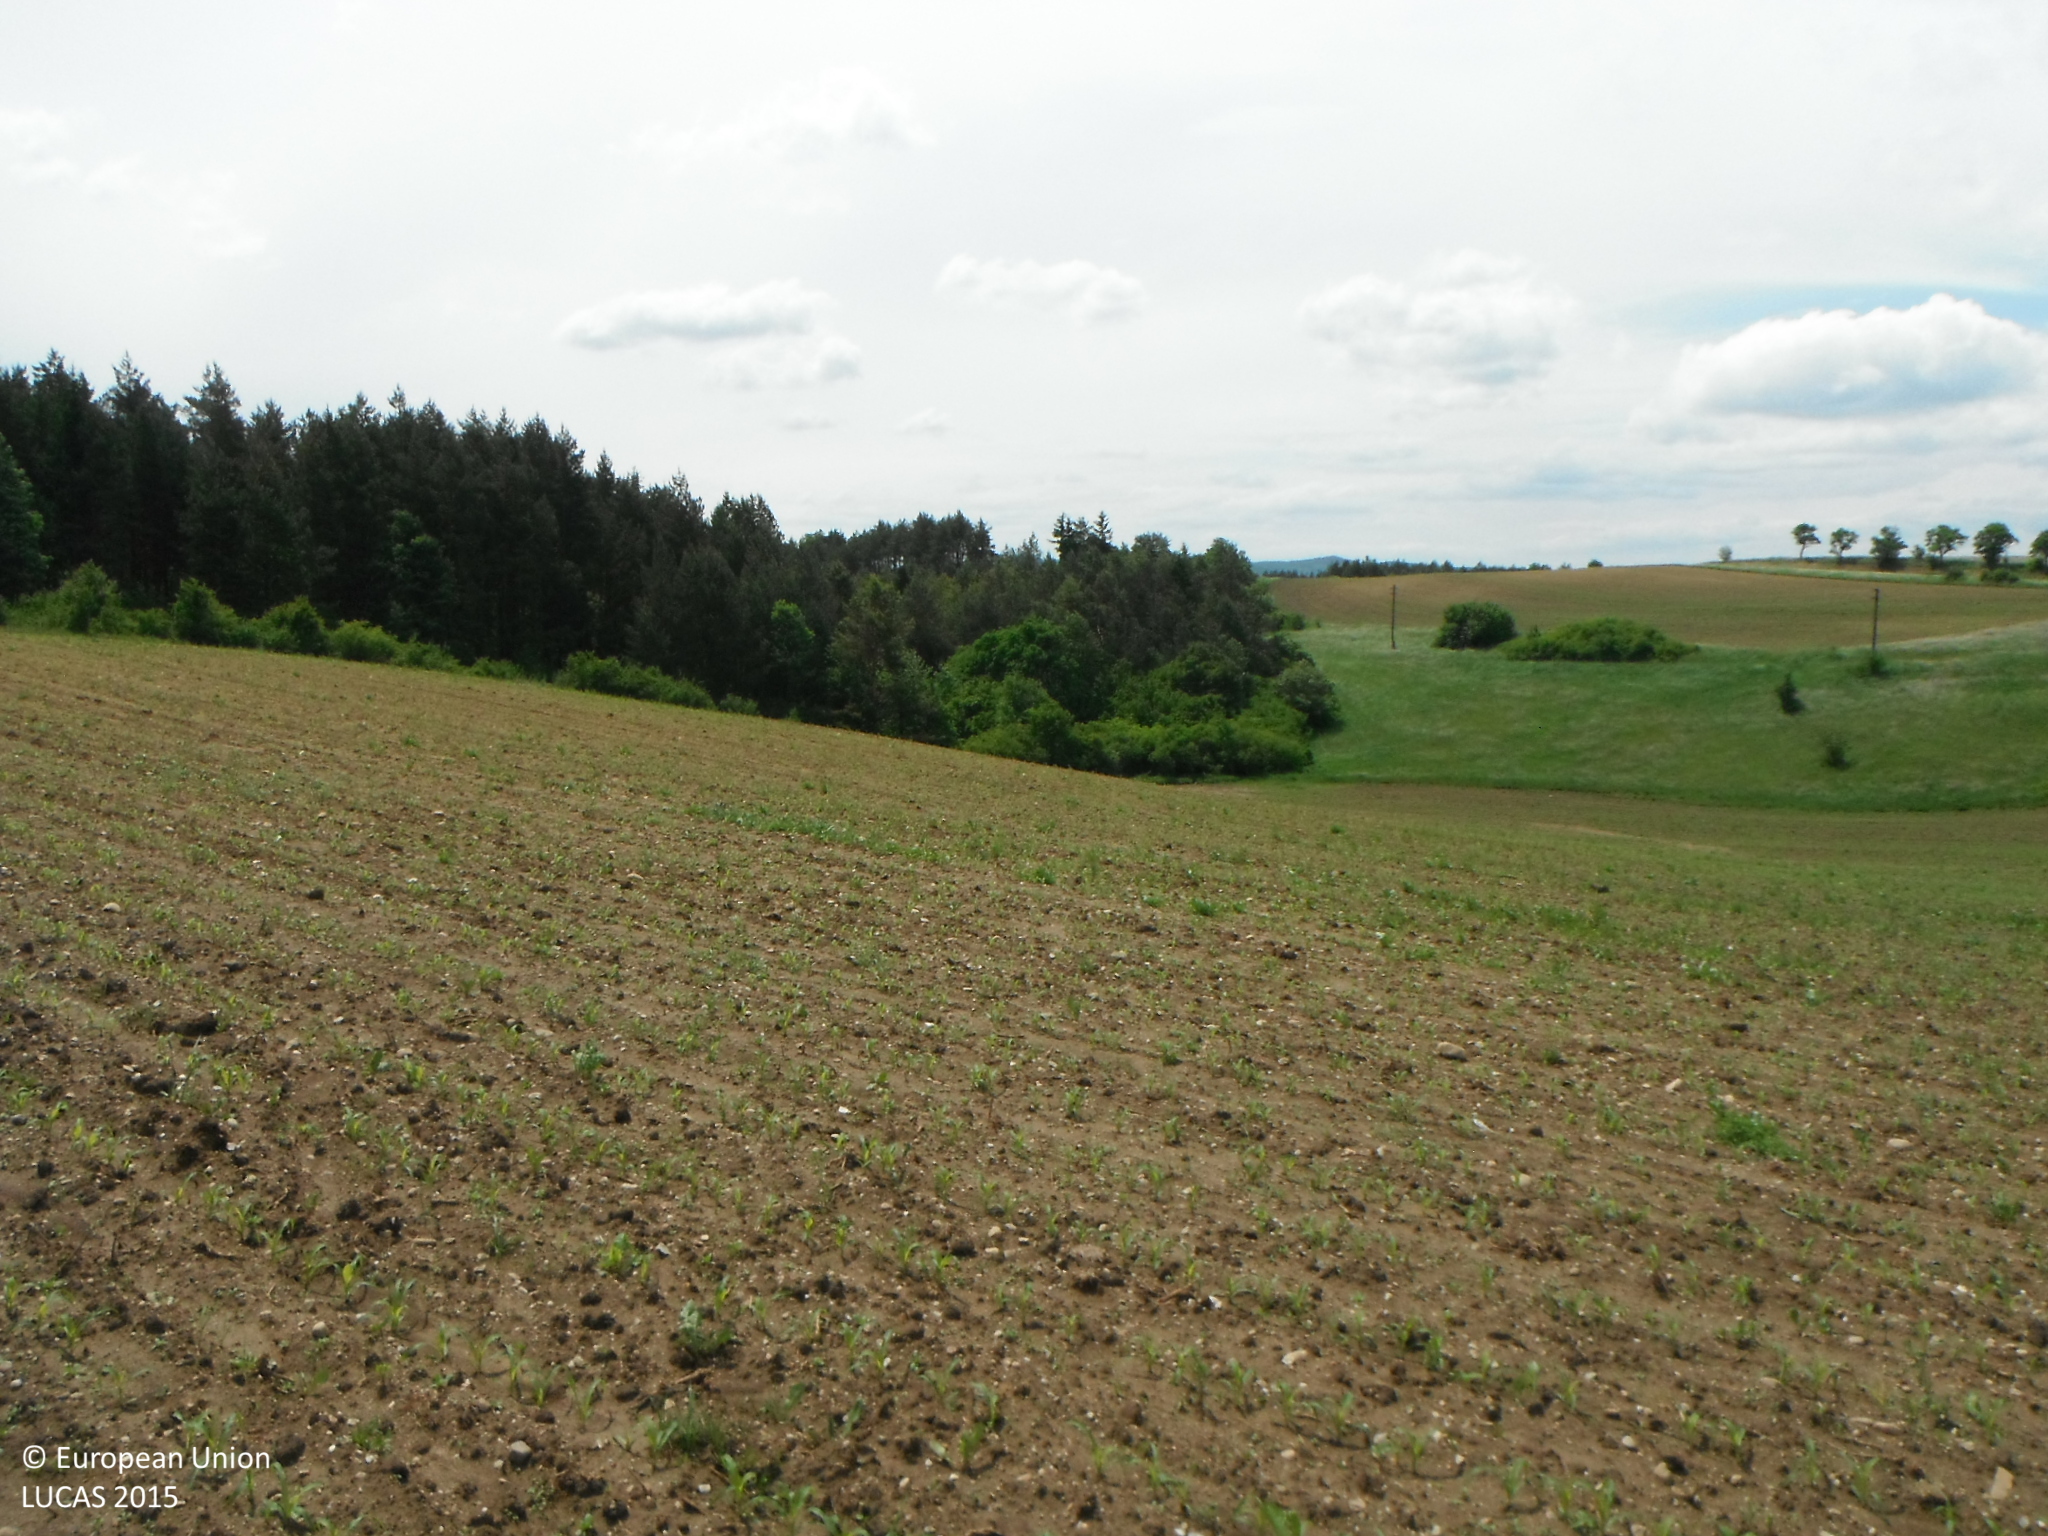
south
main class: Artificial land
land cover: Other artificial areas
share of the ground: > 75 %
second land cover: Maize
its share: < 10 %
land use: Electricity, gas and thermal power distribution
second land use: Agriculture (excluding fallow land and kitchen gardens)
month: May
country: SK
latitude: 48.7923
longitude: 19.2661
